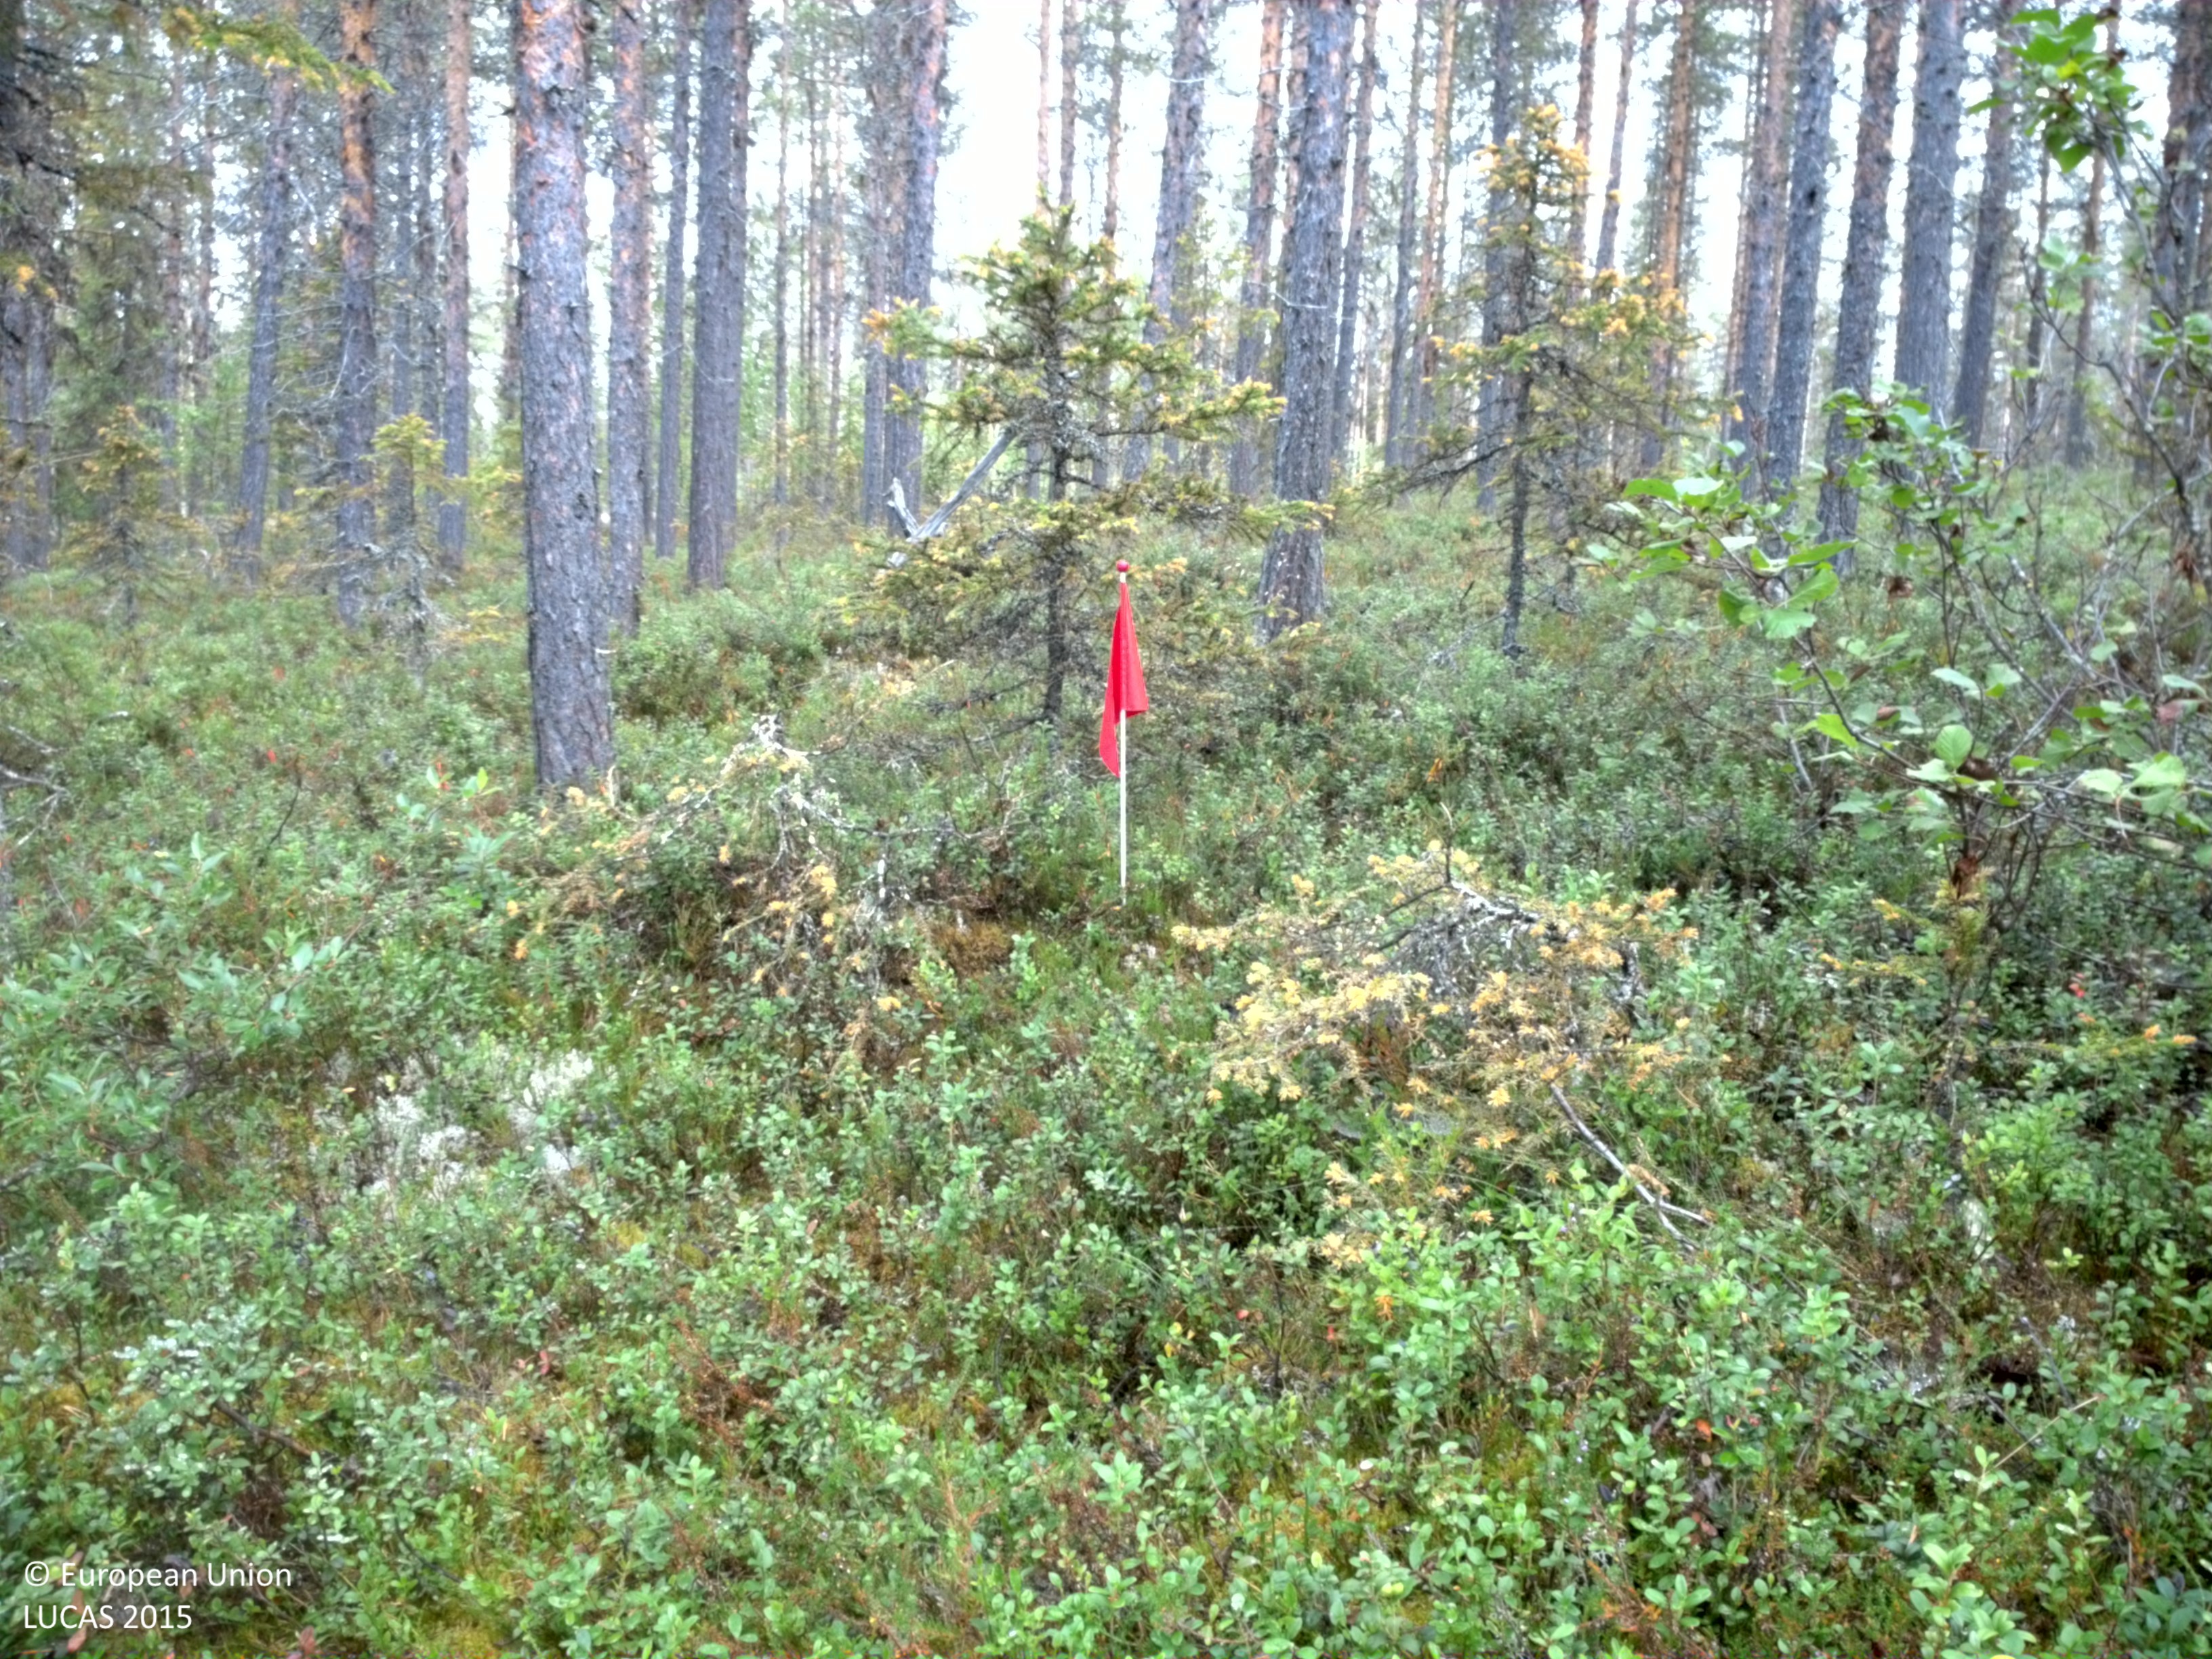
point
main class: Woodland
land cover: Pine dominated coniferous woodland
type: boreal forest
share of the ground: 25 - 50 %
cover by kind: shrubs 65 %, coniferous forest trees 30 %, broadleaved forest trees 5 %
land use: Forestry
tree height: > 5 m
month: August
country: SE
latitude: 66.5855
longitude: 19.6264
